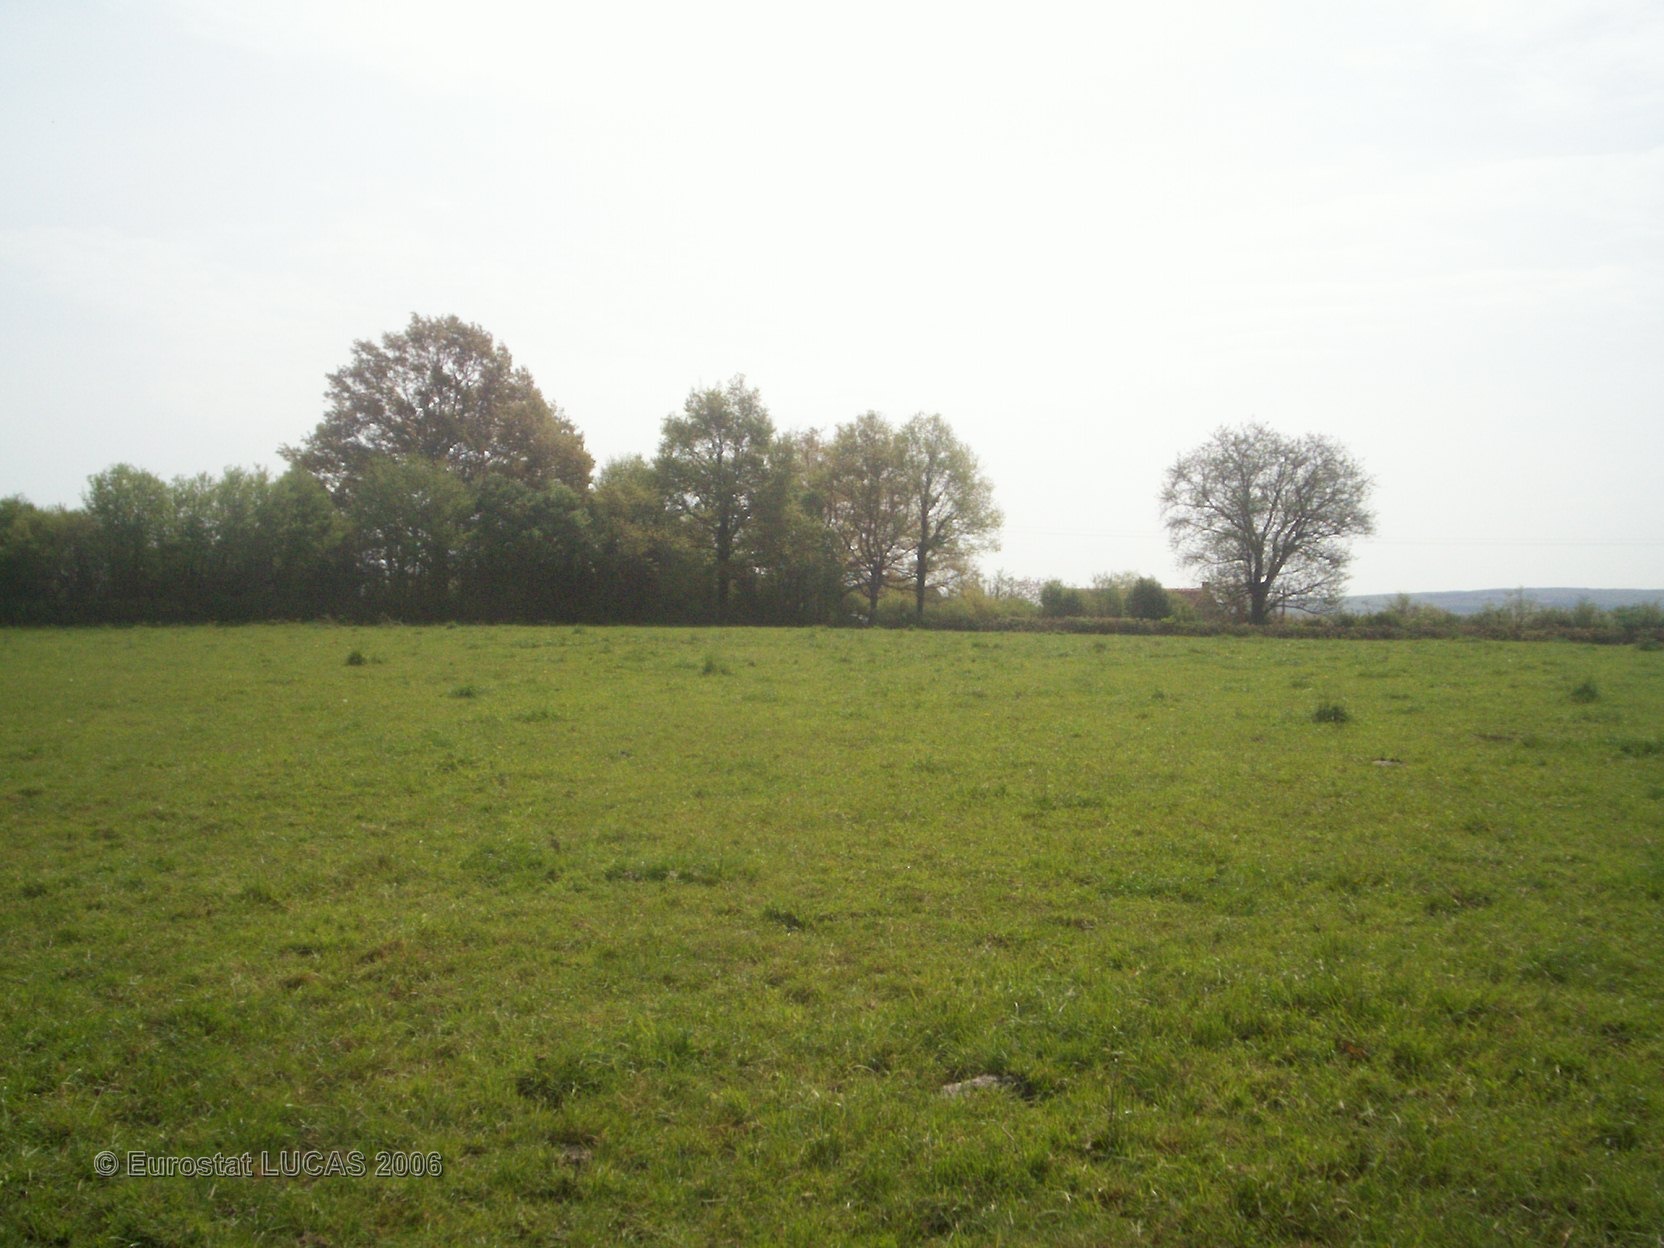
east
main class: Grassland
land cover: Grassland without tree/shrub cover
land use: Agriculture (excluding fallow land and kitchen gardens)
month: May
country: FR
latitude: 46.5601
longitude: 3.0705
